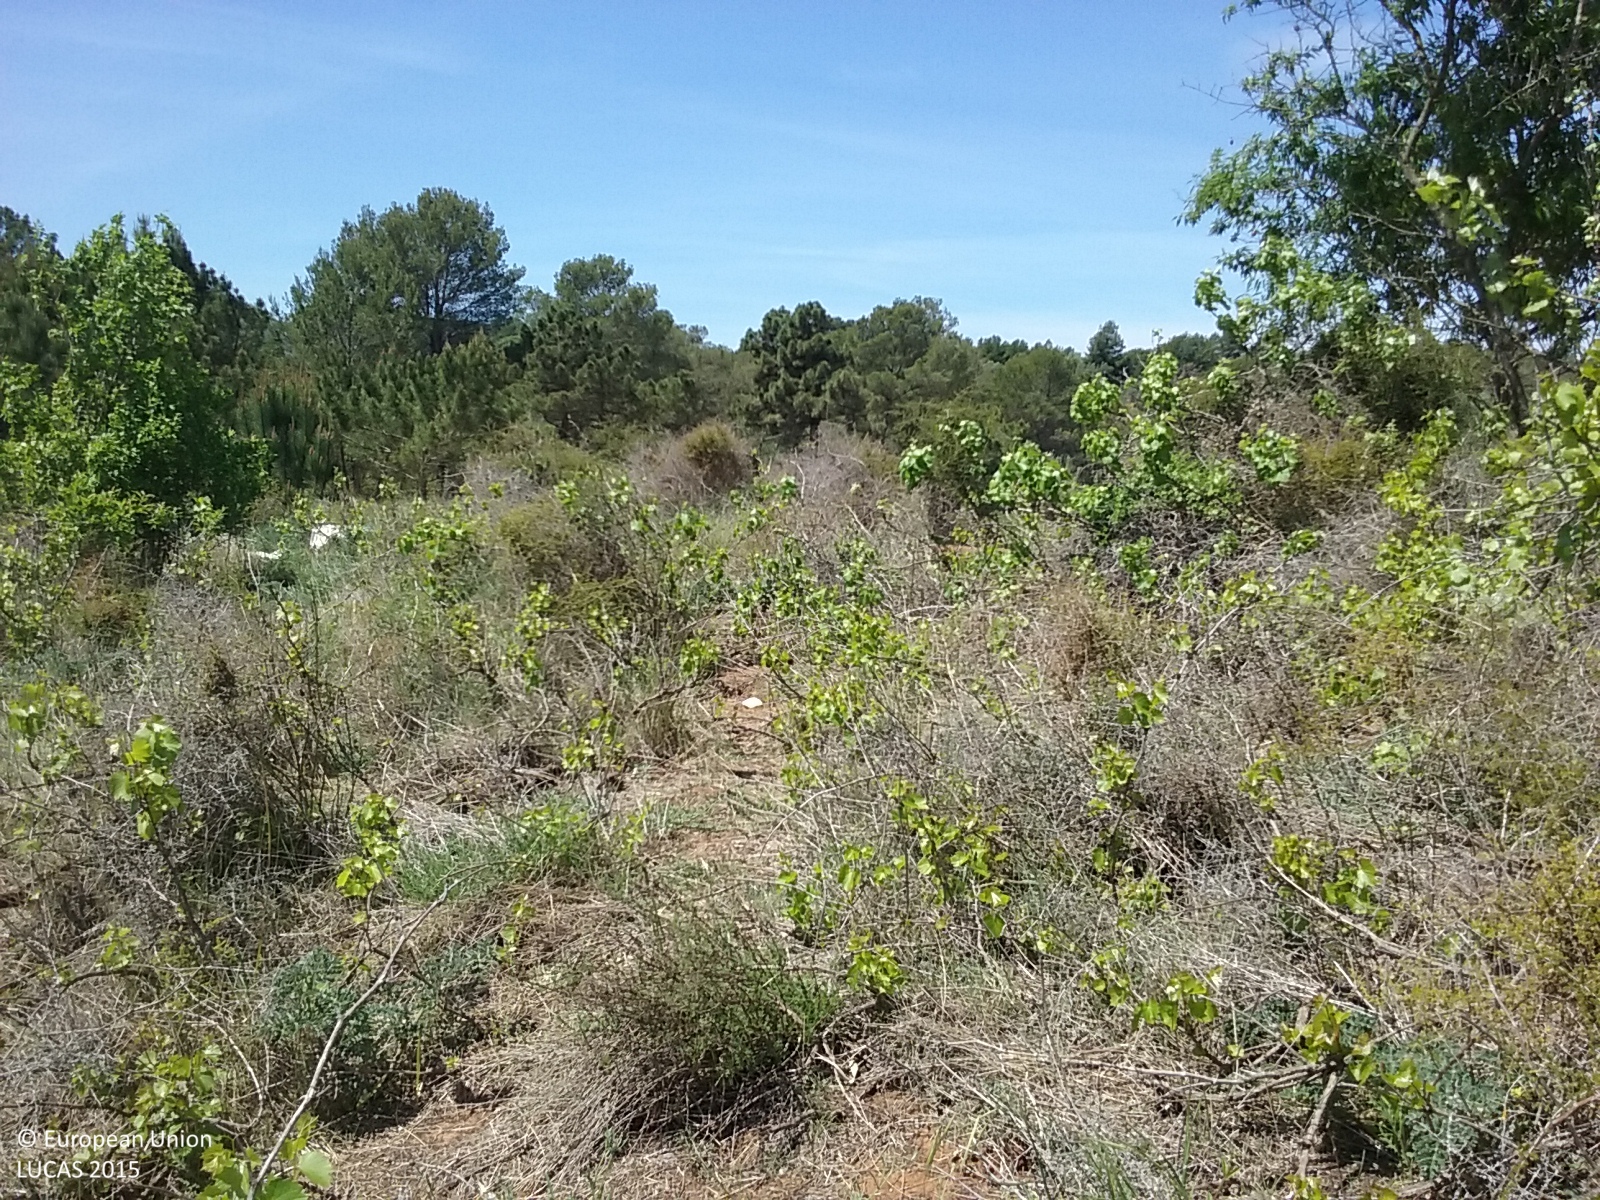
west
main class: Shrubland
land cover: Shrubland with sparse tree cover
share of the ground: > 75 %
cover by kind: herbaceous plants 75 %, shrubs 20 %, broadleaved forest trees 5 %
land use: Abandoned areas
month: May
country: ES
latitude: 40.1208
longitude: 0.0123
